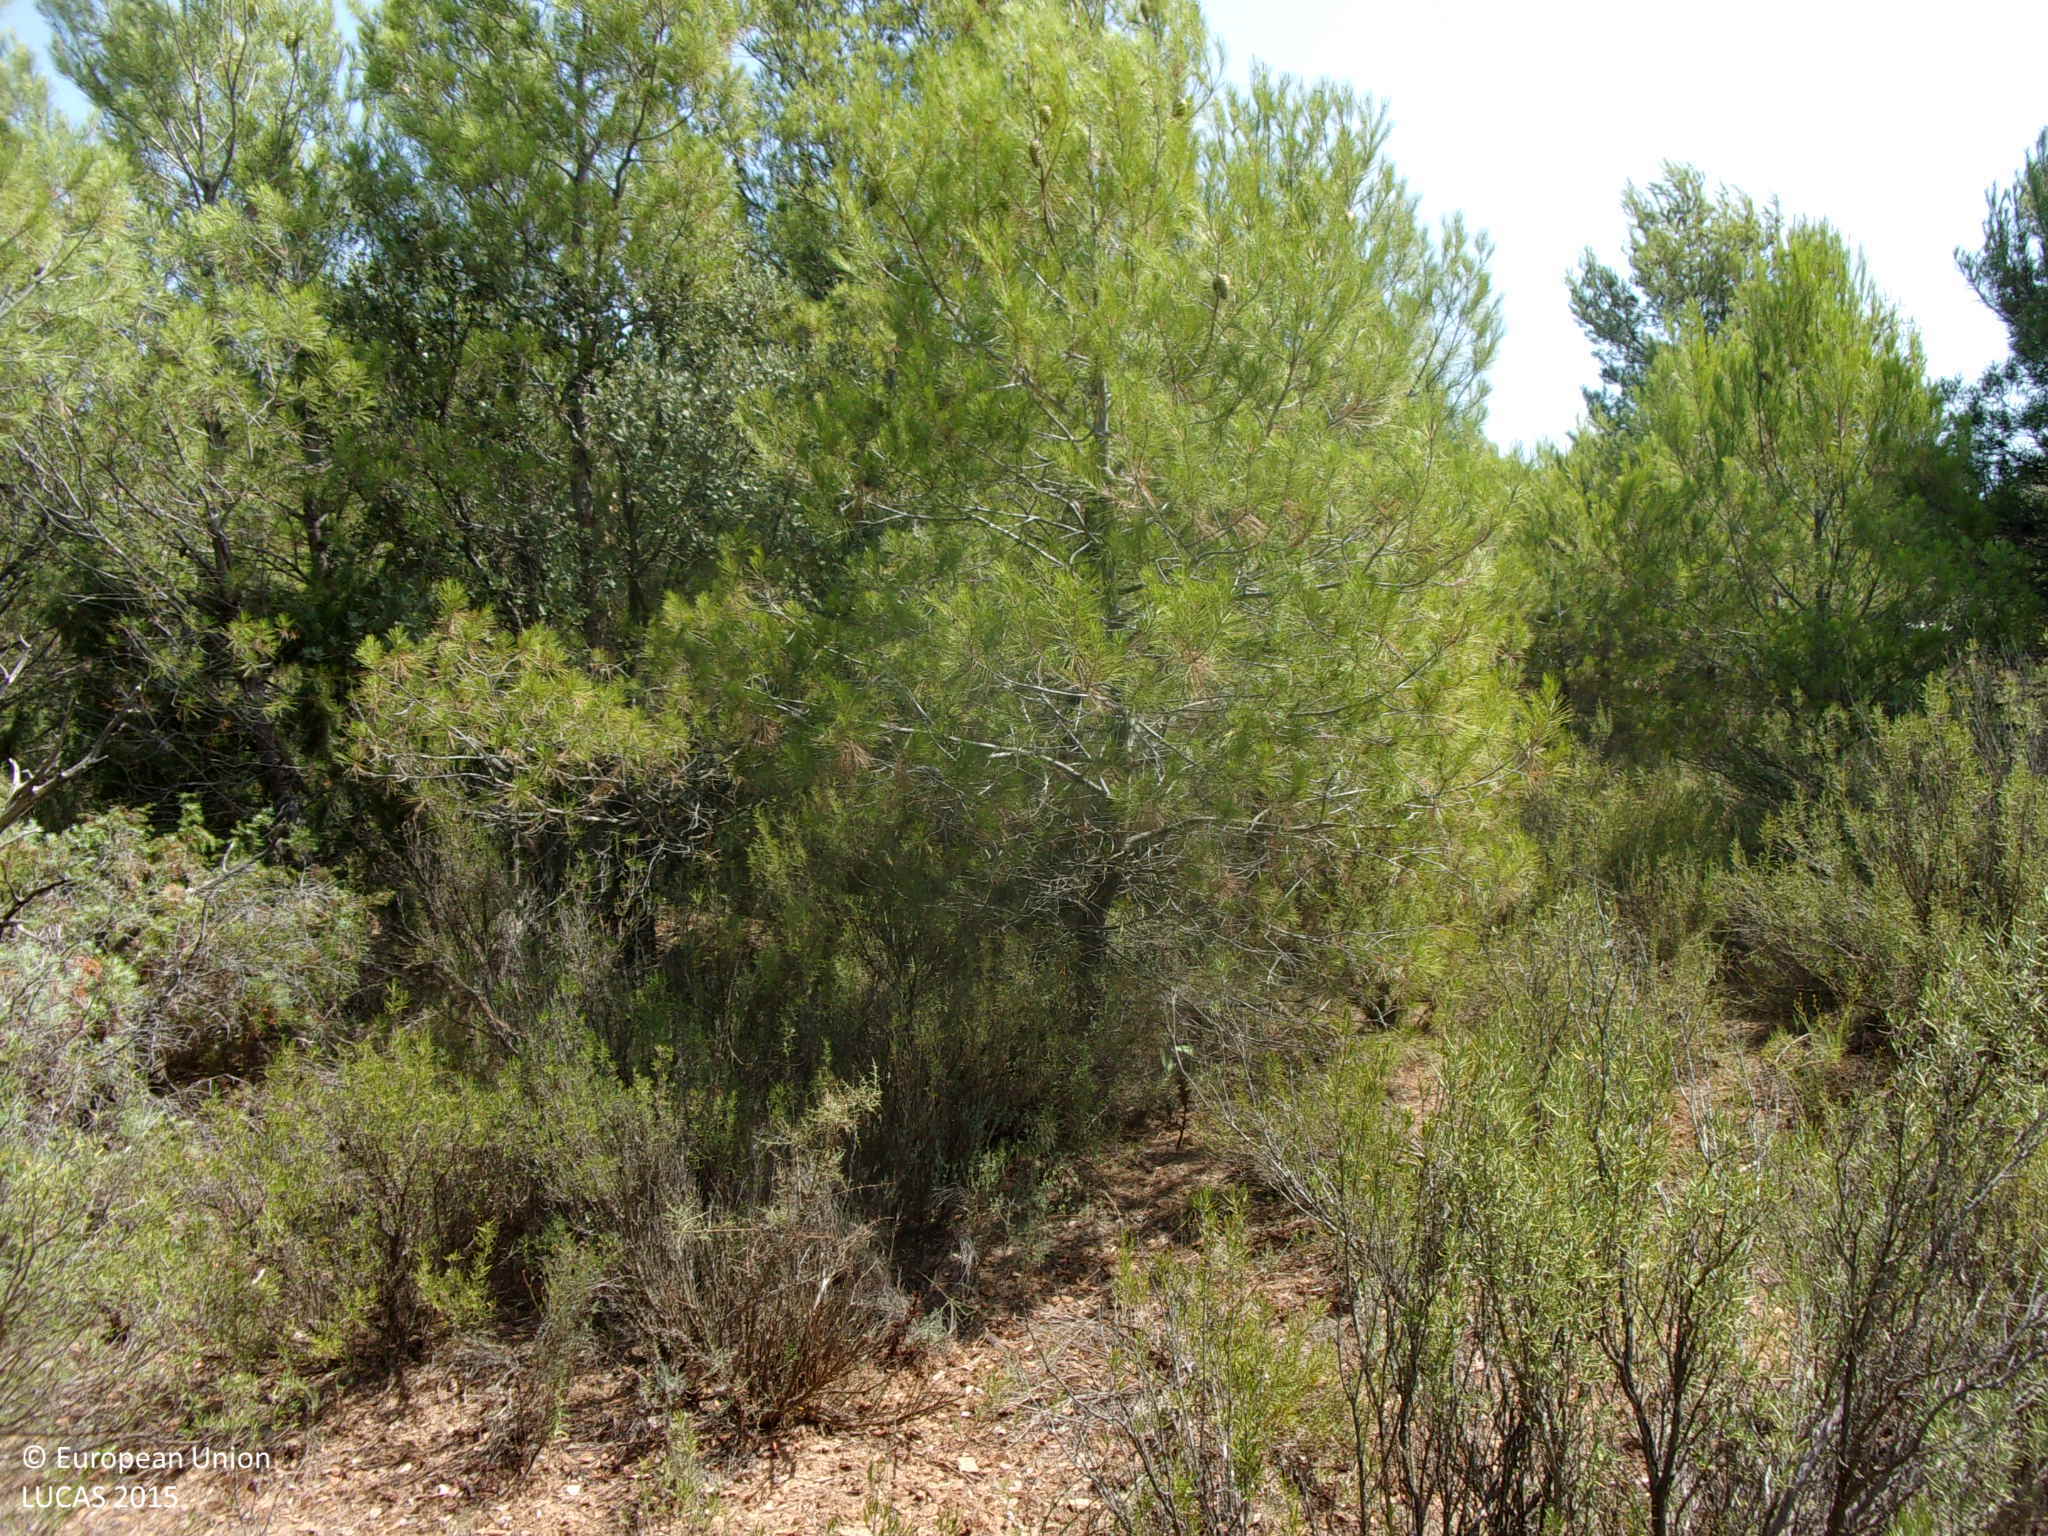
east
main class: Woodland
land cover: Pine dominated mixed woodland
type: coniferous forest of the mediterranean region
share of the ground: > 75 %
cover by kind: coniferous forest trees 60 %, broadleaved forest trees 30 %, shrubs 10 %
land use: Forestry
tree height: < 5 m
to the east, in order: Pine dominated mixed woodland; Common wheat; Pine dominated mixed woodland; Common wheat
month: August
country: ES
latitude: 42.4810
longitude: -1.4079
